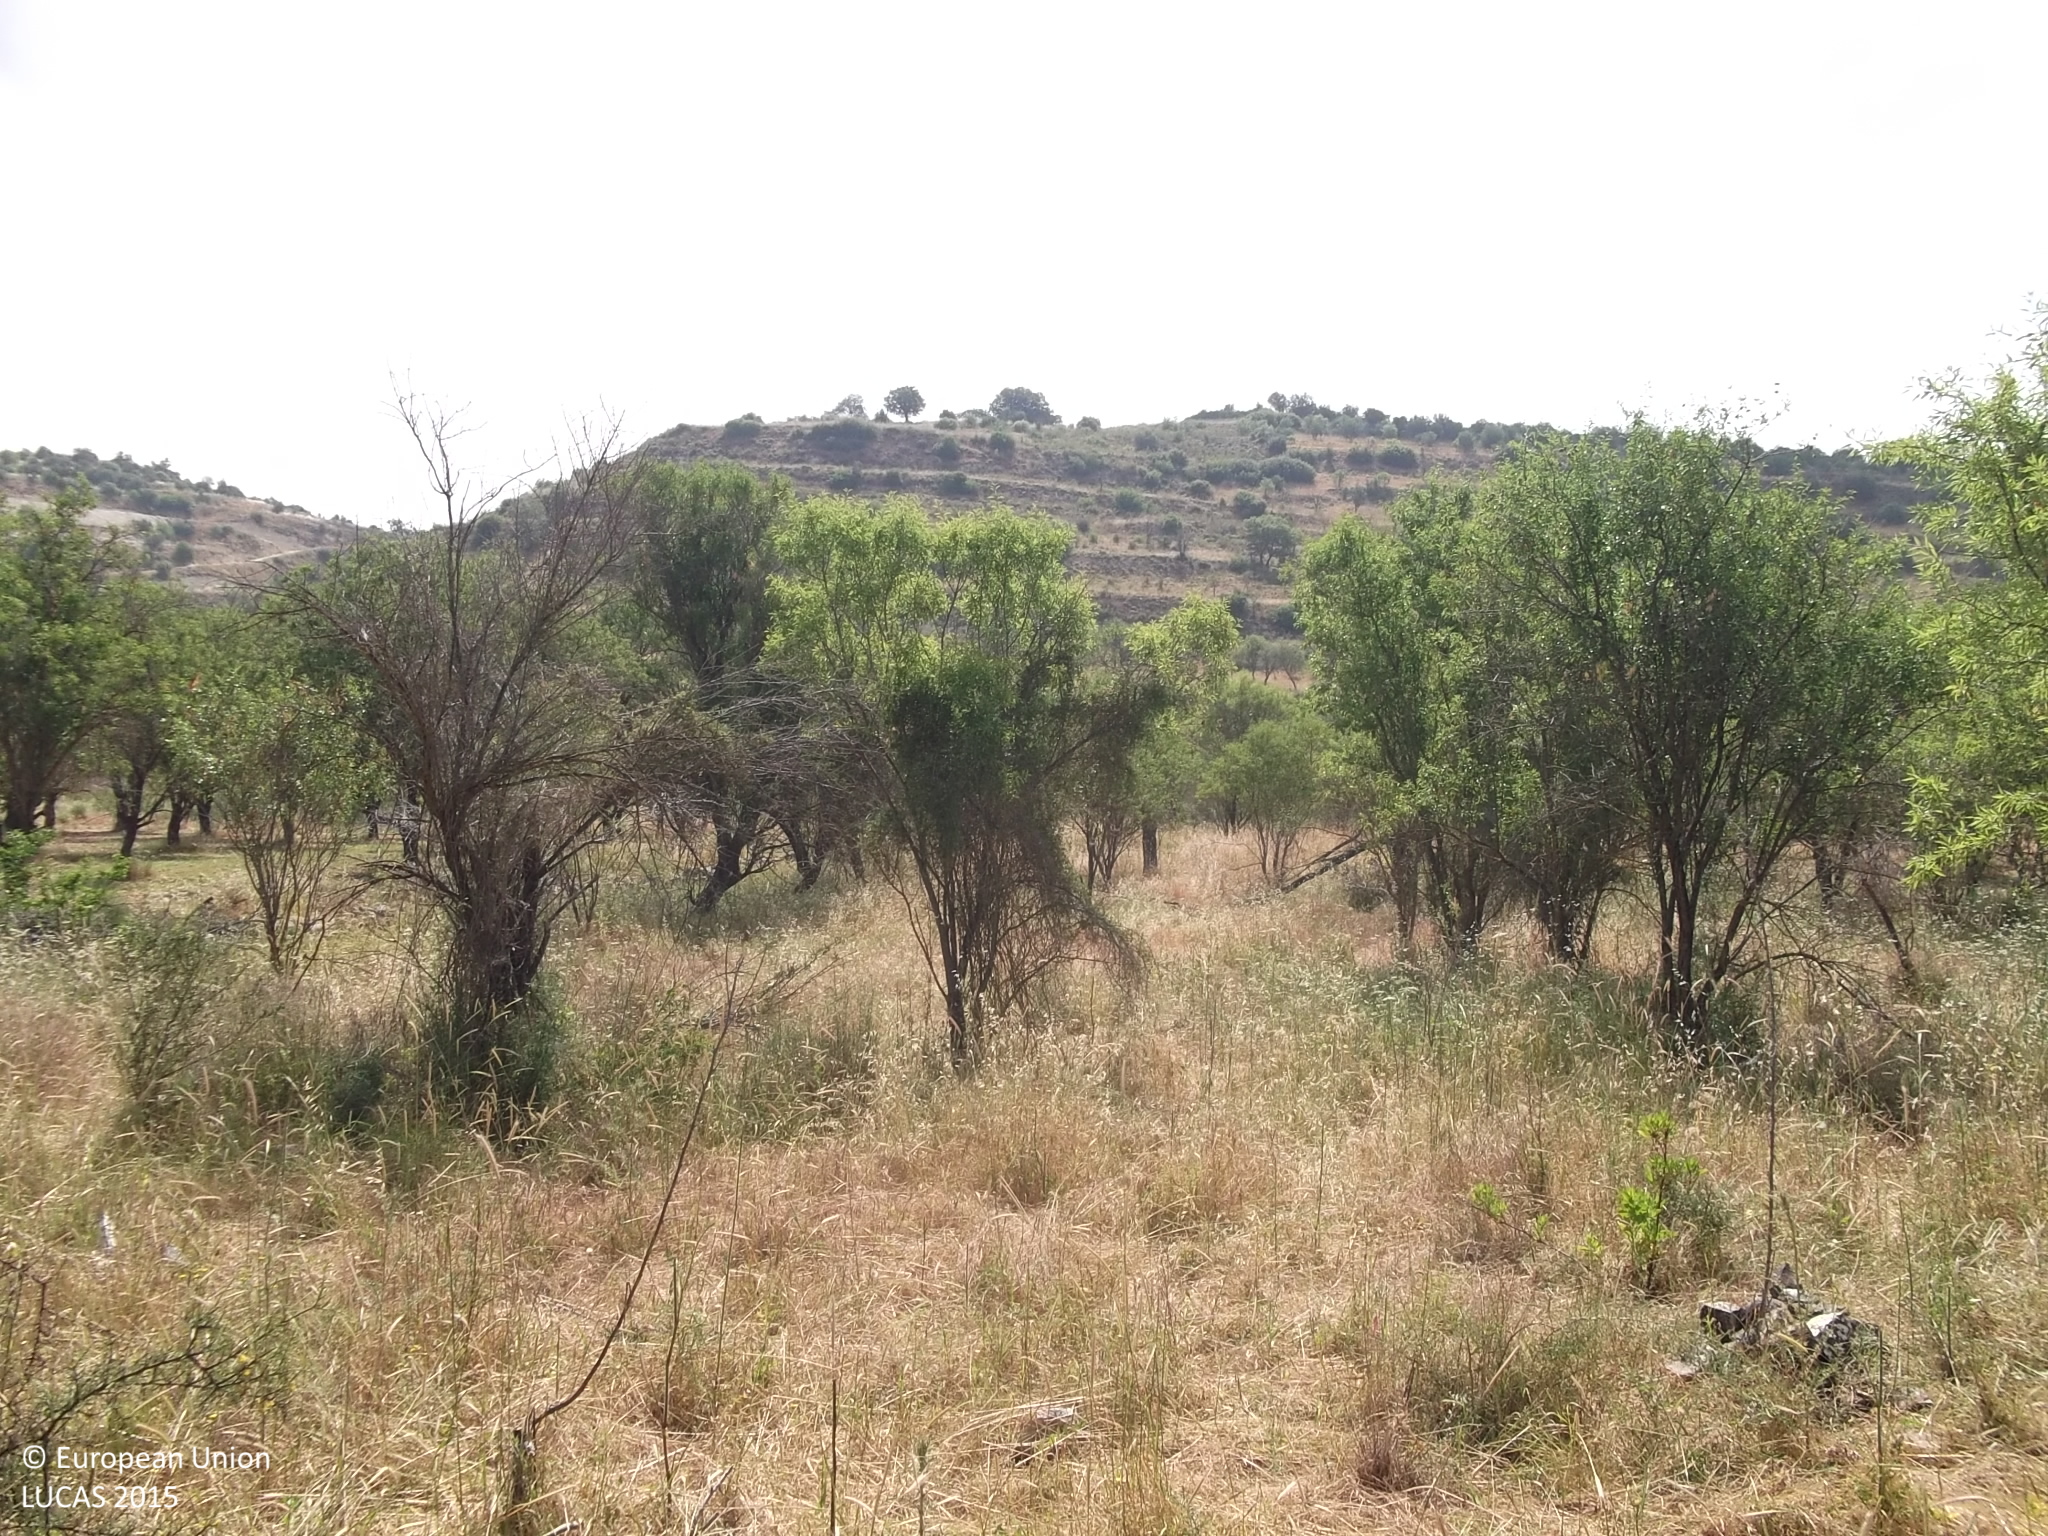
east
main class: Shrubland
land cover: Shrubland with sparse tree cover
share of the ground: 25 - 50 %
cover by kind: shrubs 50 %, herbaceous plants 35 %, unconsolidated bare surface 10 %, broadleaved forest trees 5 %
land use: Semi-natural and natural areas not in use
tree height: < 5 m
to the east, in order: Shrubland with sparse tree cover; Grassland with sparse tree/shrub cover; Nuts trees; Rock outcrops; Grassland without tree/shrub cover; Tracks; Grassland without tree/shrub cover; Rivers and streams; Grassland without tree/shrub cover
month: May
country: CY
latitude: 34.8714
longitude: 32.5459
